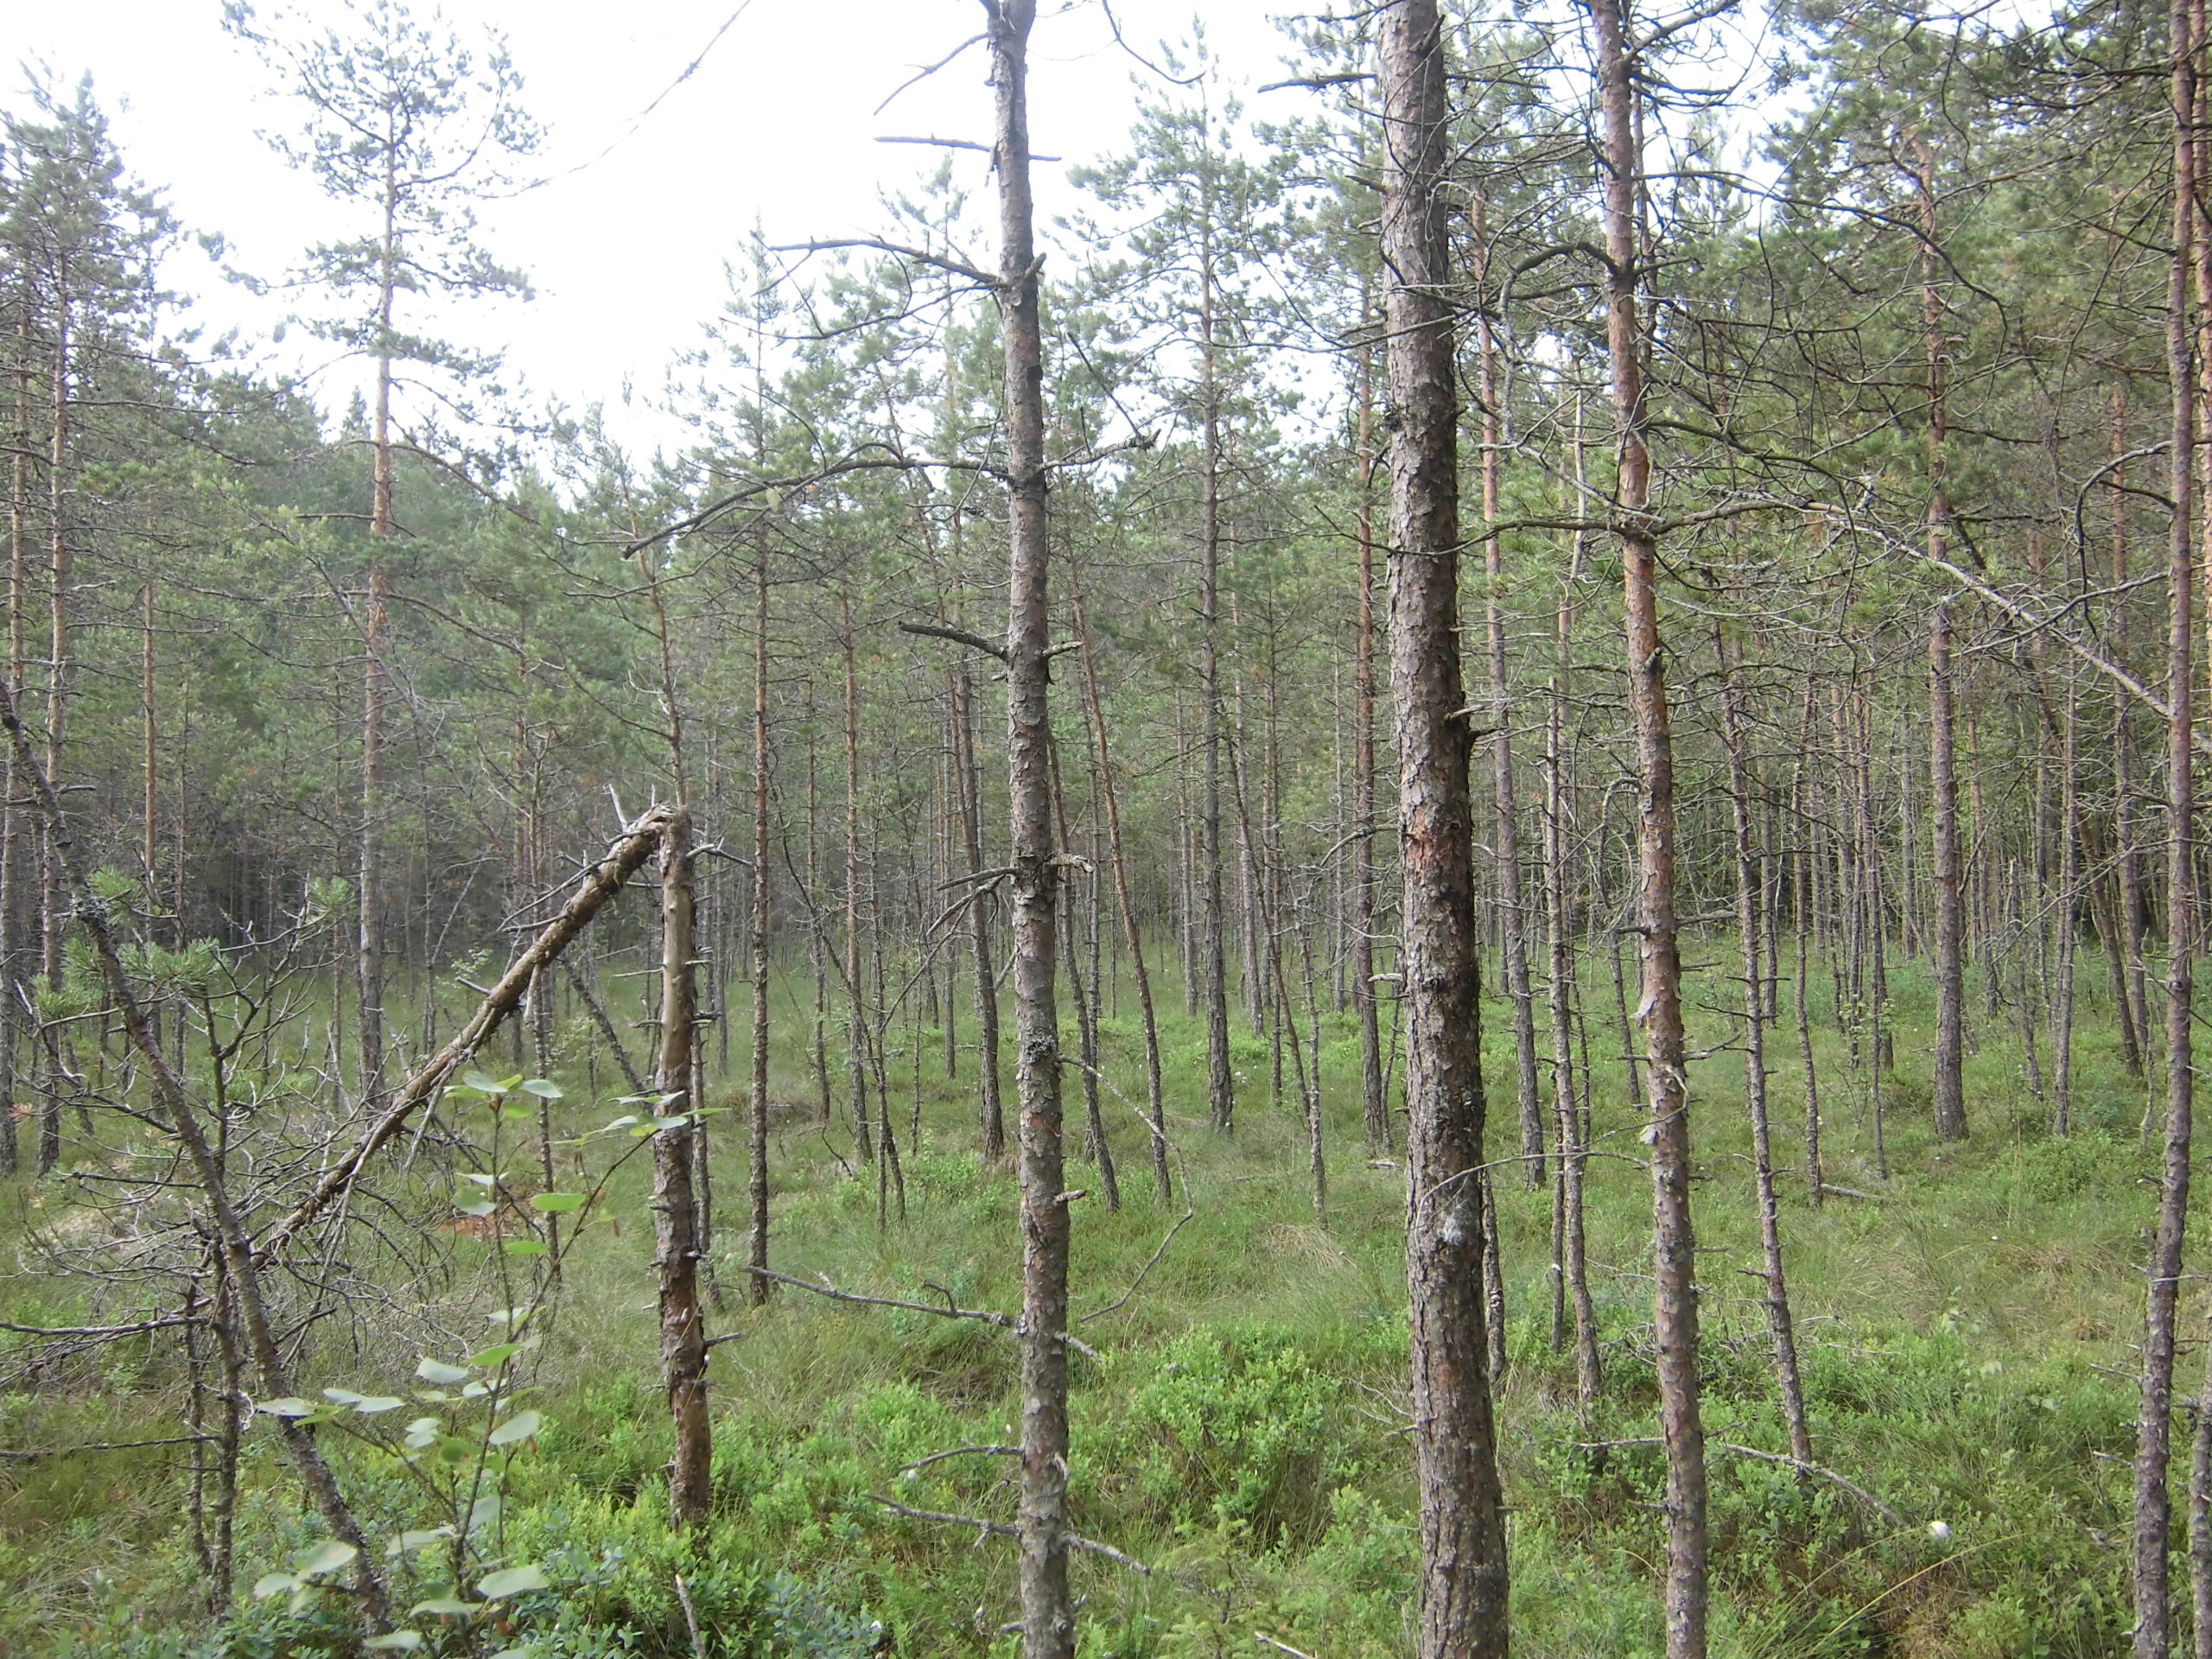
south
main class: Woodland
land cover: Pine dominated coniferous woodland
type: boreal forest
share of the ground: 50 - 75 %
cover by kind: coniferous forest trees 55 %, shrubs 20 %, herbaceous plants 10 %, lichens and mosses 10 %, broadleaved forest trees 5 %
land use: Forestry
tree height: > 5 m
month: July
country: SE
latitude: 57.4499
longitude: 14.7786
